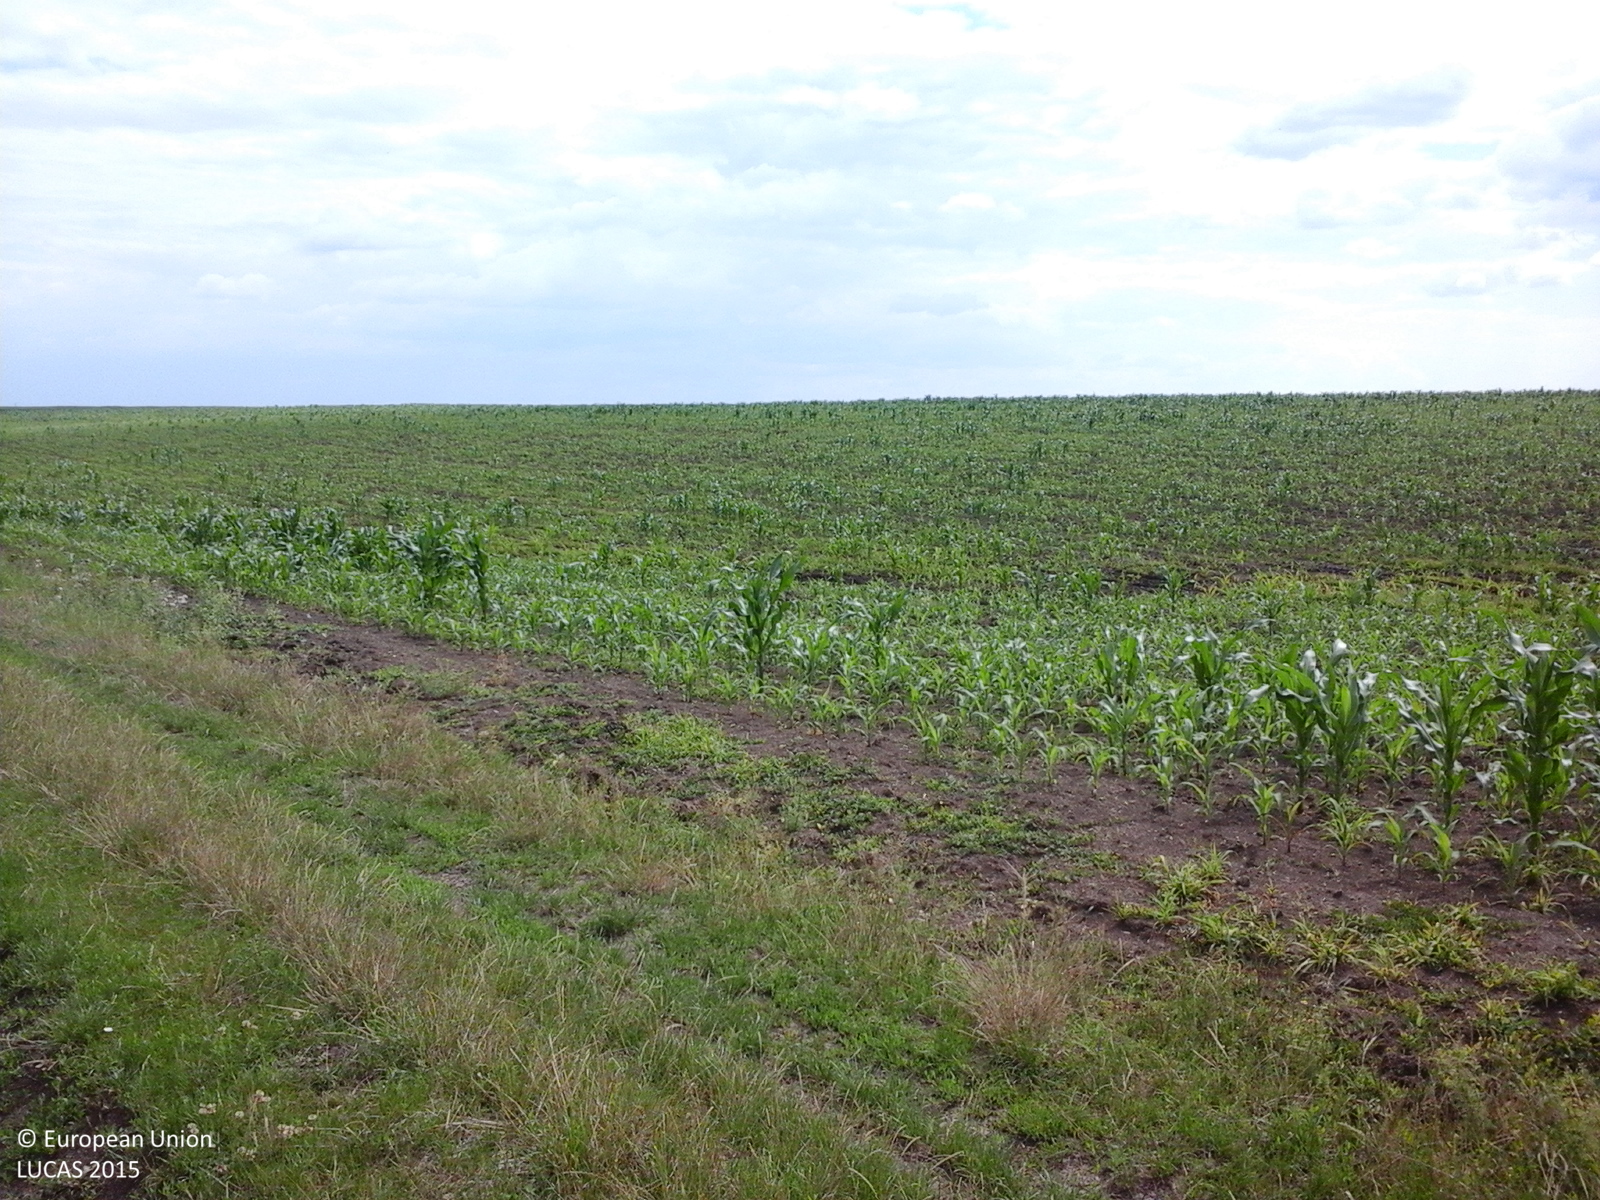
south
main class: Cropland
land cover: Sunflower
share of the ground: > 75 %
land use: Agriculture (excluding fallow land and kitchen gardens)
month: July
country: RO
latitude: 44.3530
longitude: 24.7401
